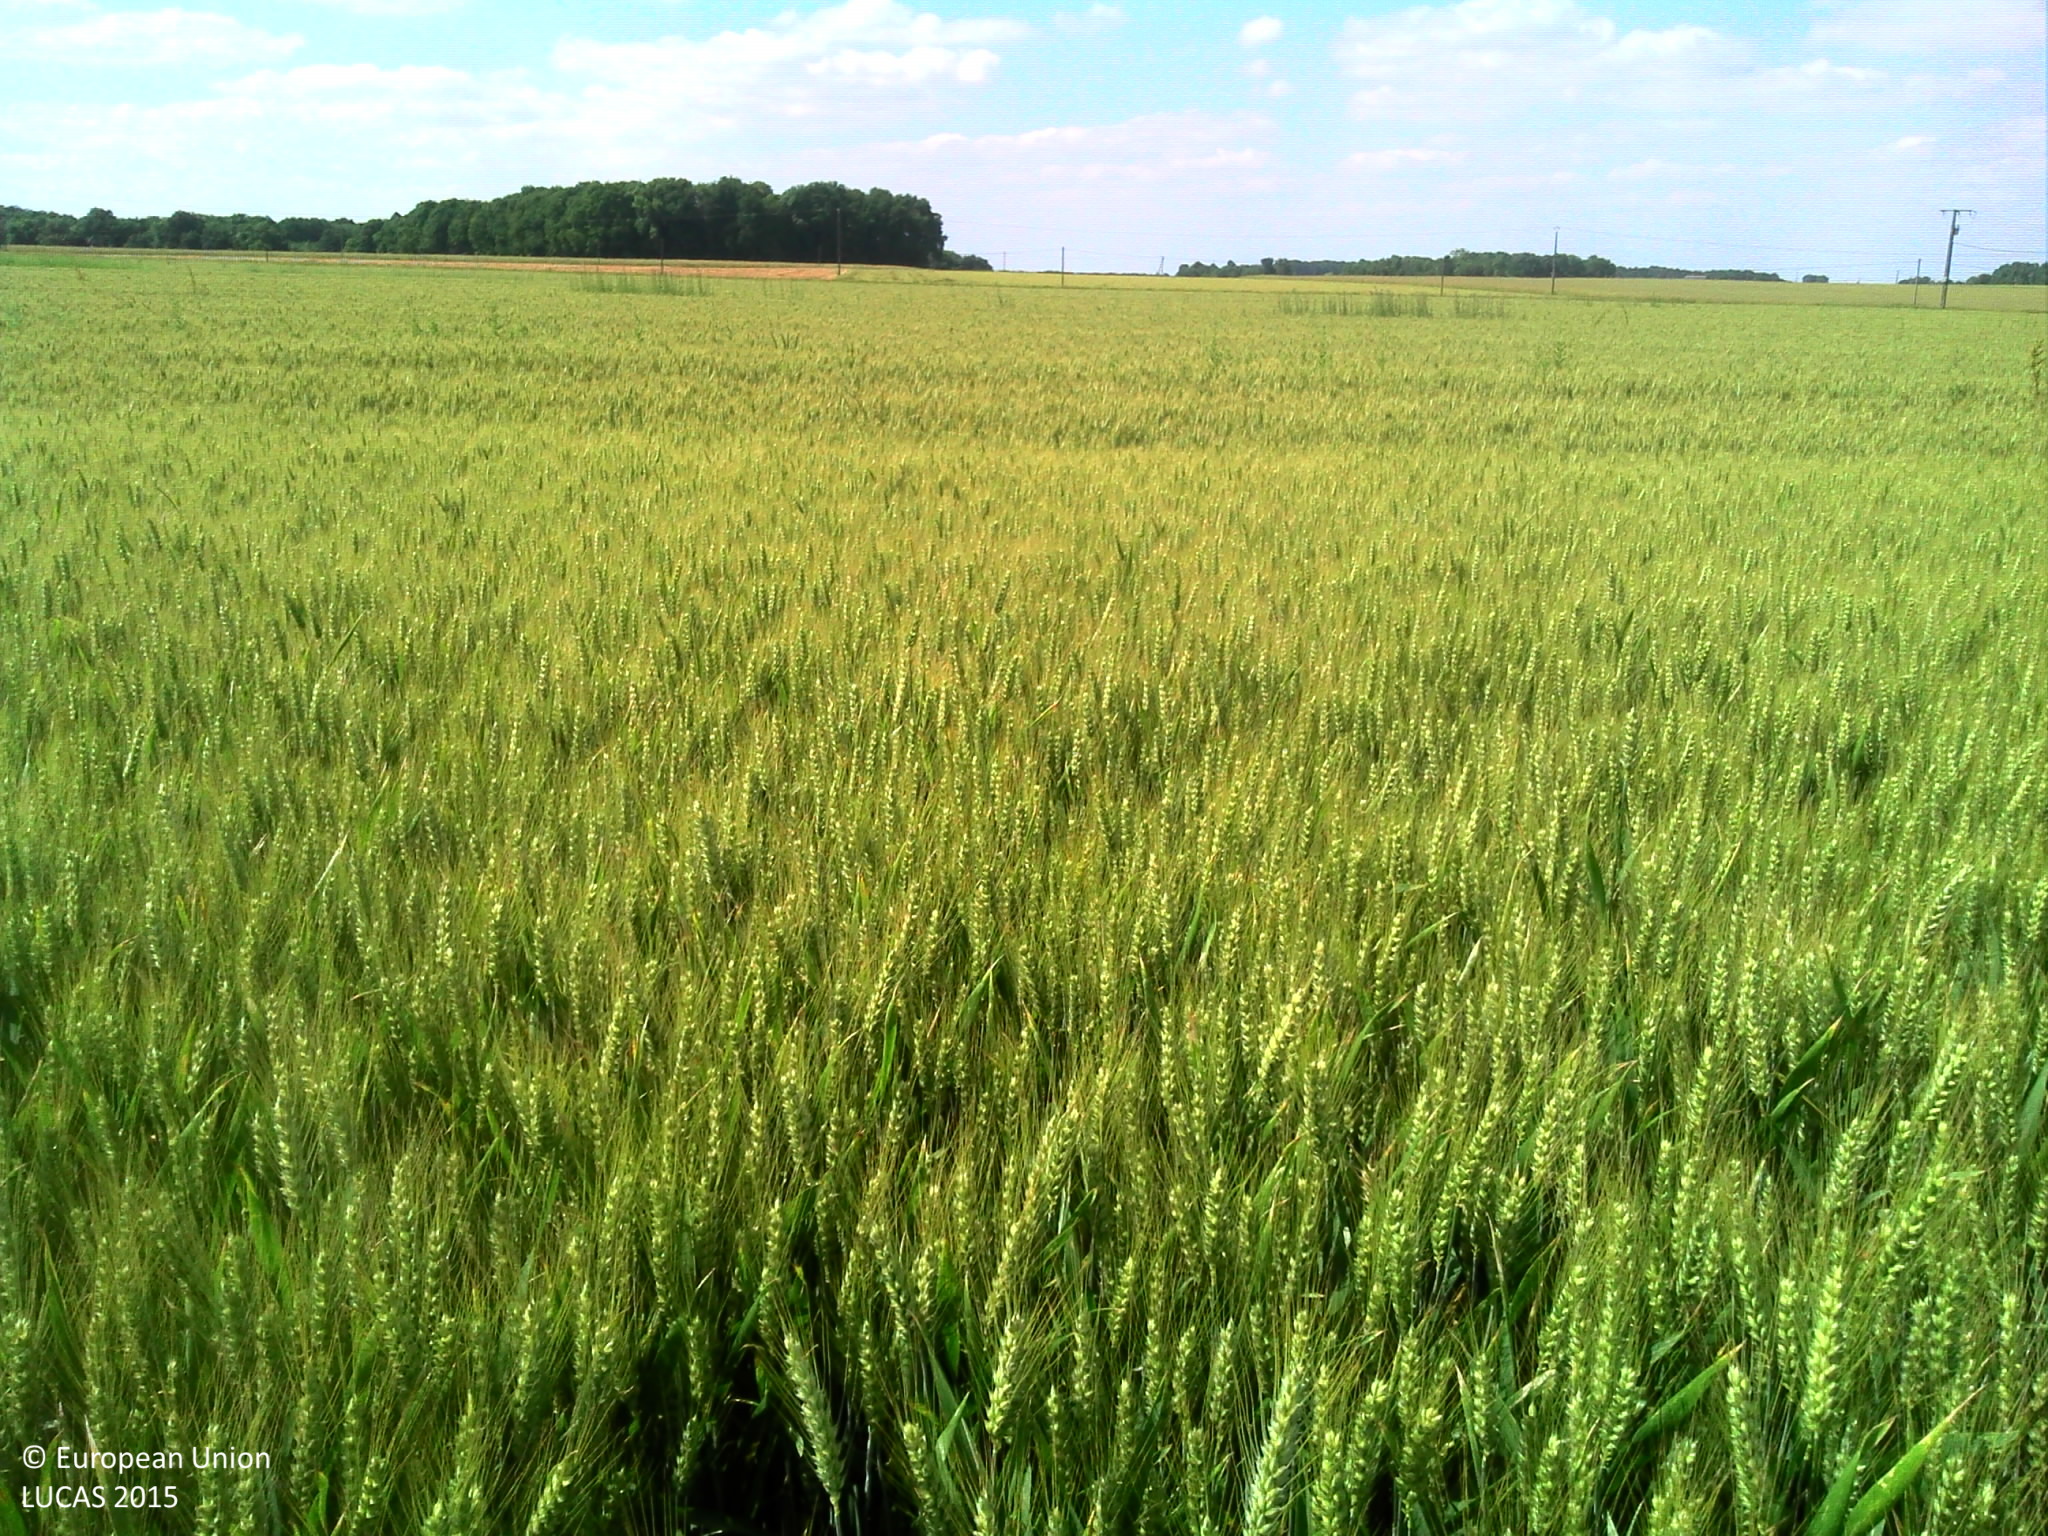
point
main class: Cropland
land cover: Durum wheat
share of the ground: > 75 %
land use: Agriculture (excluding fallow land and kitchen gardens)
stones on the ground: < 10 %
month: June
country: FR
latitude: 47.5567
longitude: 0.4761
